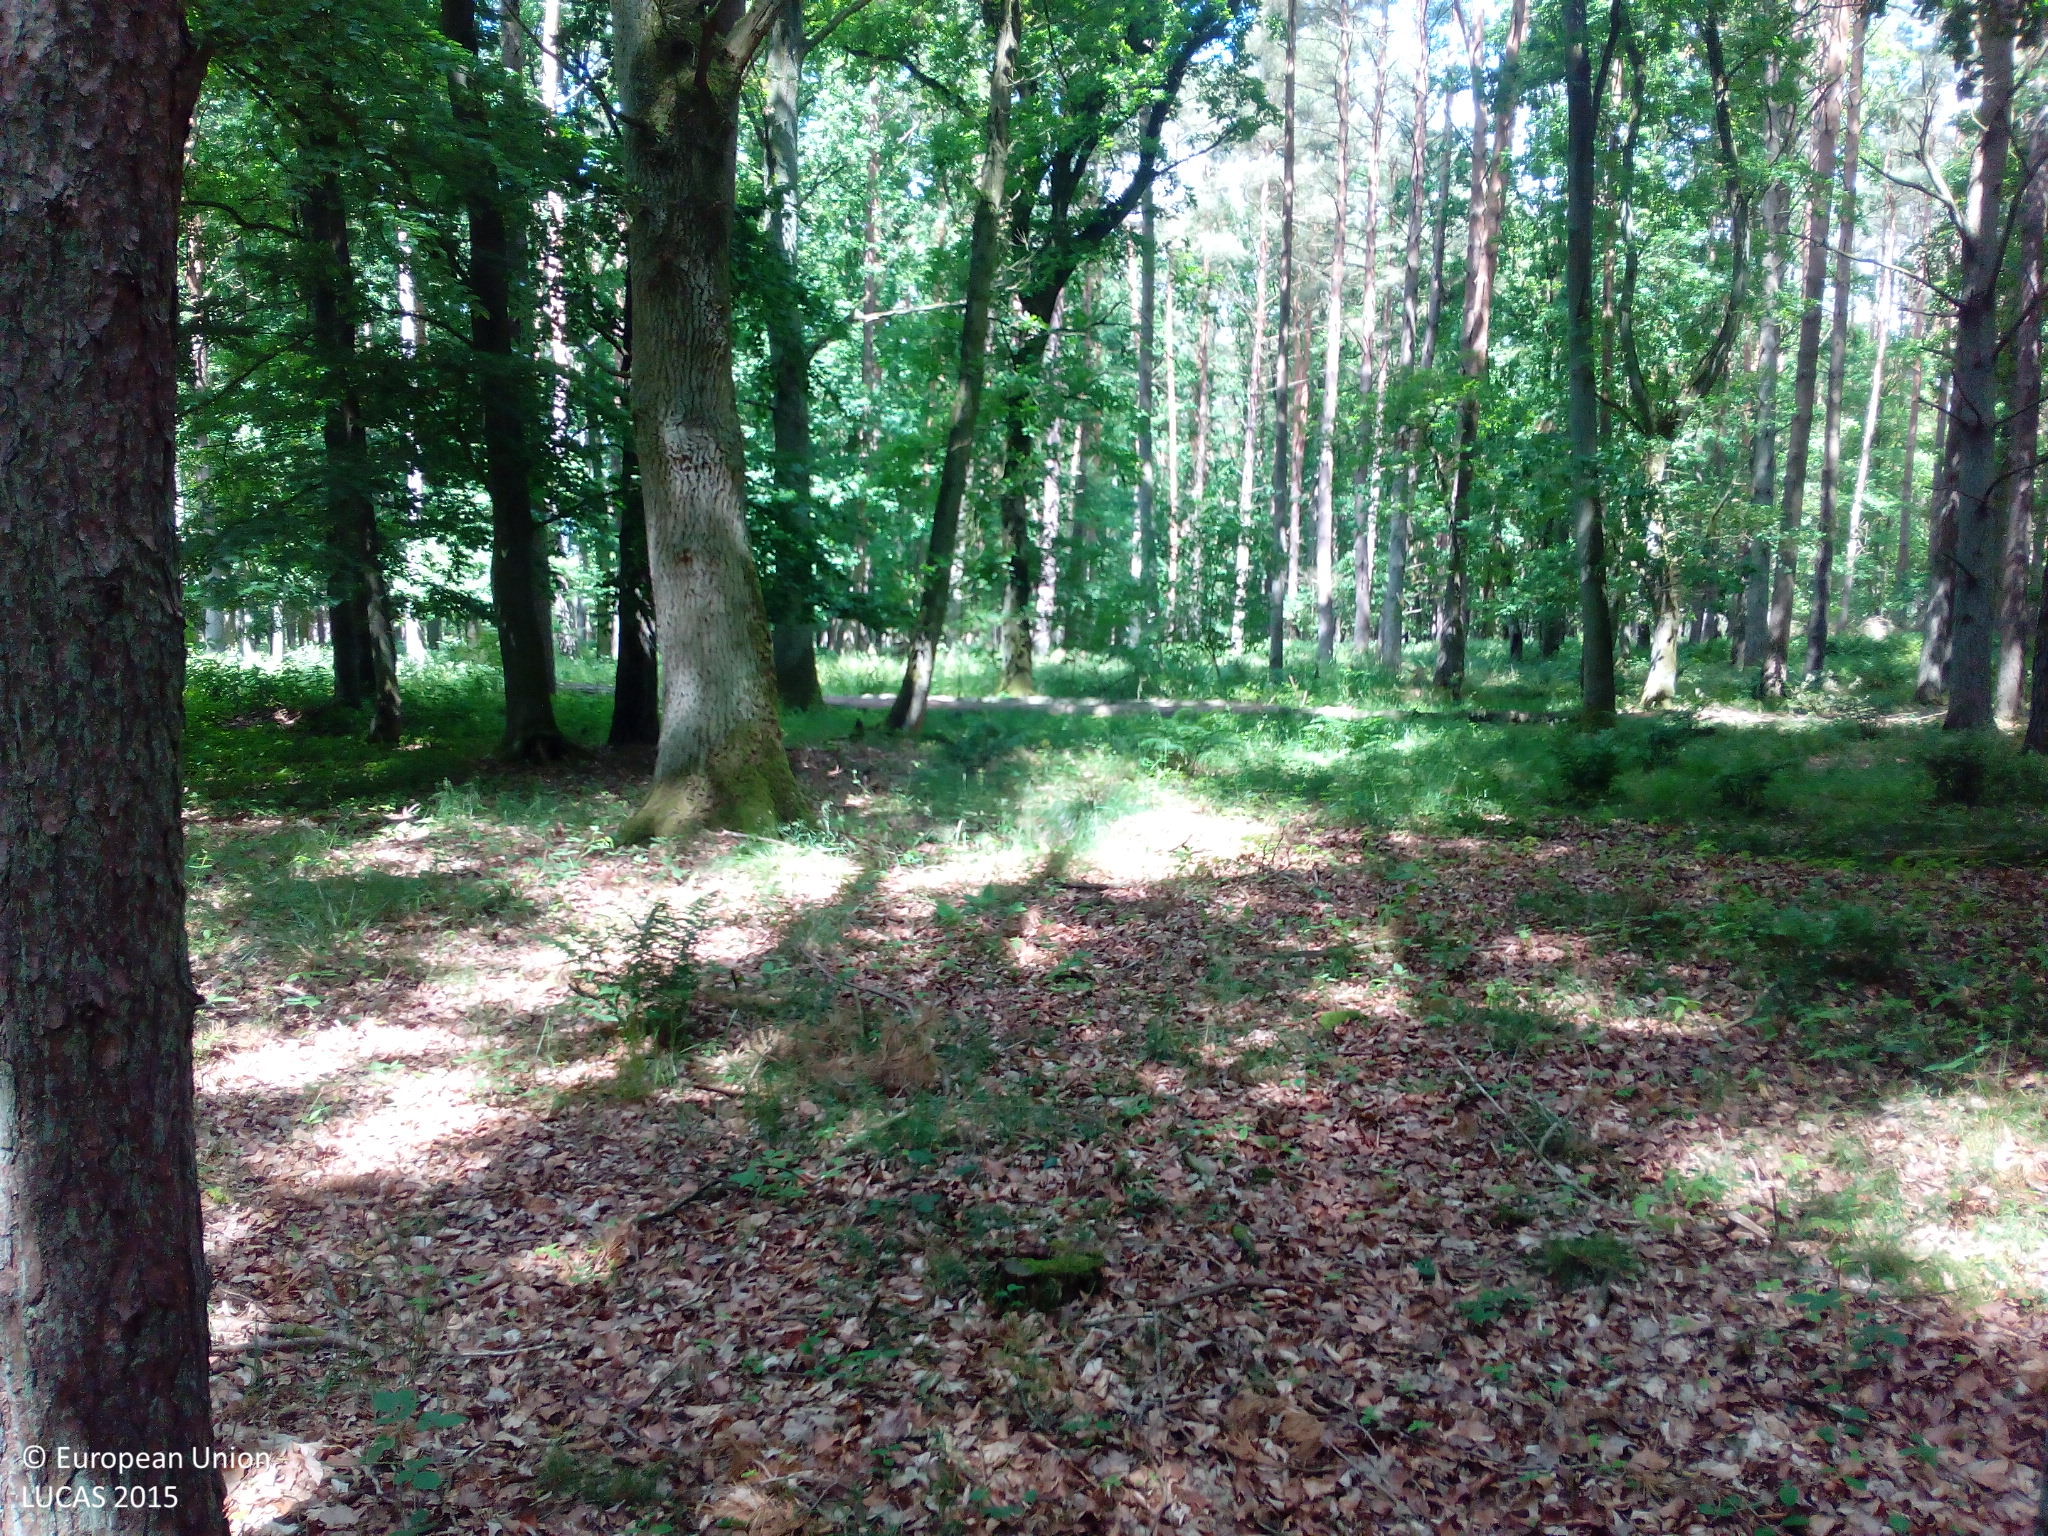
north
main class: Woodland
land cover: Pine dominated mixed woodland
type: hemiboreal forest and nemoral coniferous forest and mixed broadleaved-coniferous forest
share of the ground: > 75 %
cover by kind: coniferous forest trees 50 %, broadleaved forest trees 30 %, unconsolidated bare surface 10 %, shrubs 5 %, herbaceous plants 5 %
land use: Forestry
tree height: > 5 m
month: June
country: DE
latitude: 53.8459
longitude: 11.1394
